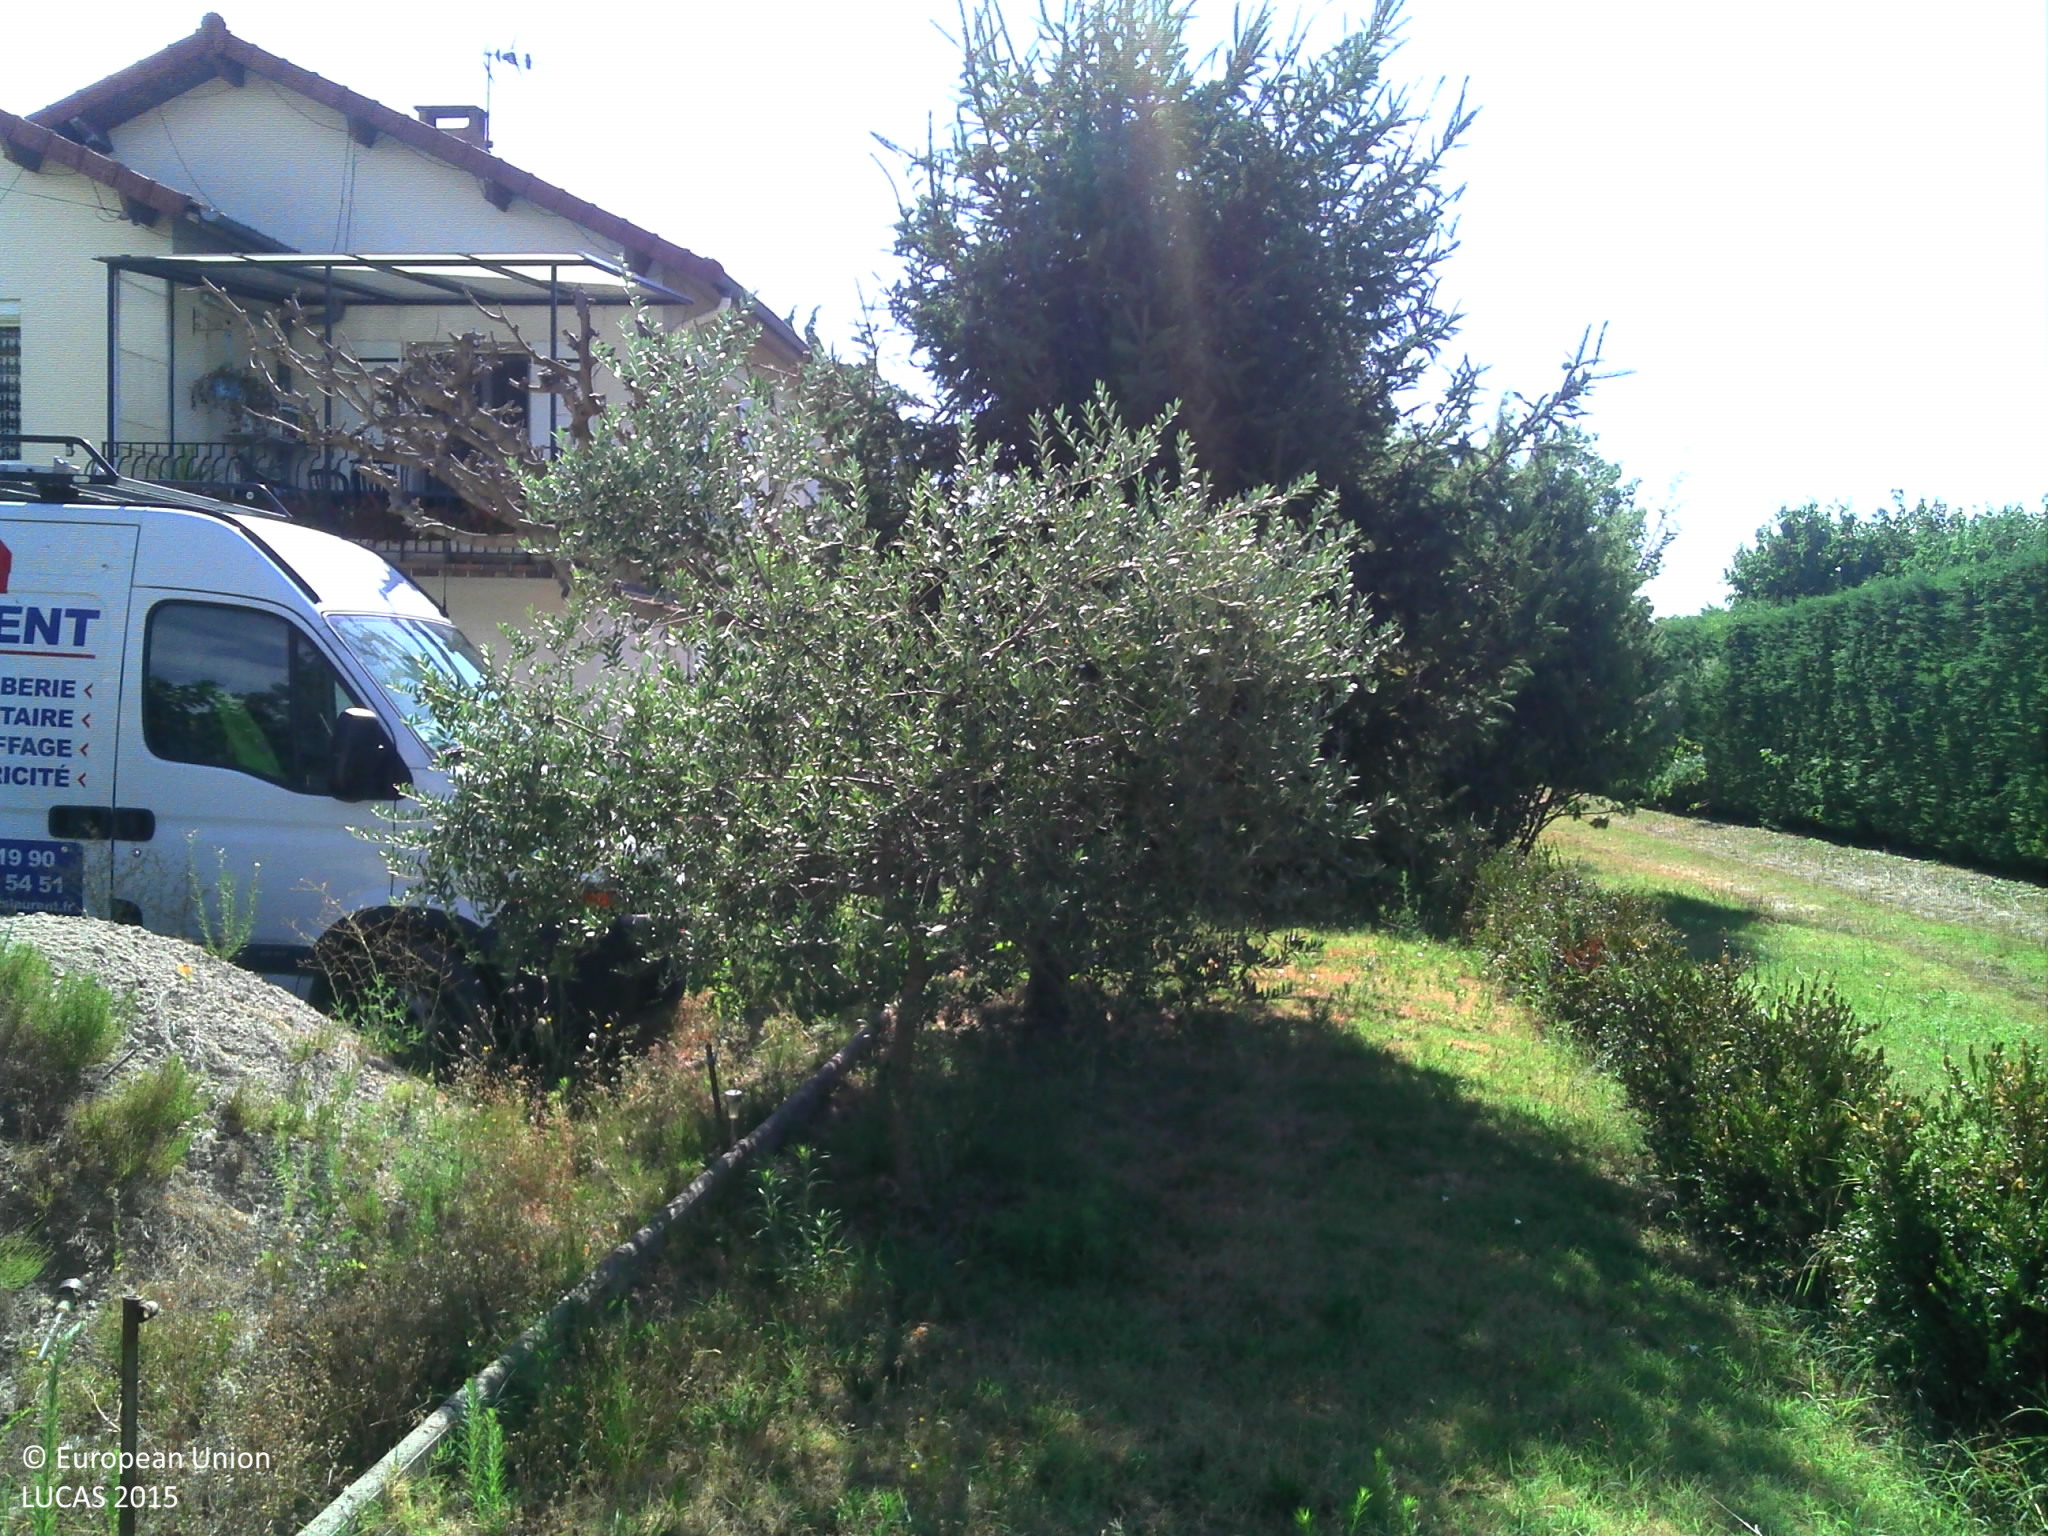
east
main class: Grassland
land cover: Grassland with sparse tree/shrub cover
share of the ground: > 75 %
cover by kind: herbaceous plants 95 %, broadleaved forest trees 5 %
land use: Residential
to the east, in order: Grassland with sparse tree/shrub cover; Artificial constructions in urban areas; Grassland without tree/shrub cover; Temporary grasslands; Other fruit trees and berries; Spontaneously vegetated surfaces; Lines of trees; Other fruit trees and berries
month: July
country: FR
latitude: 44.7976
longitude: 4.7851
